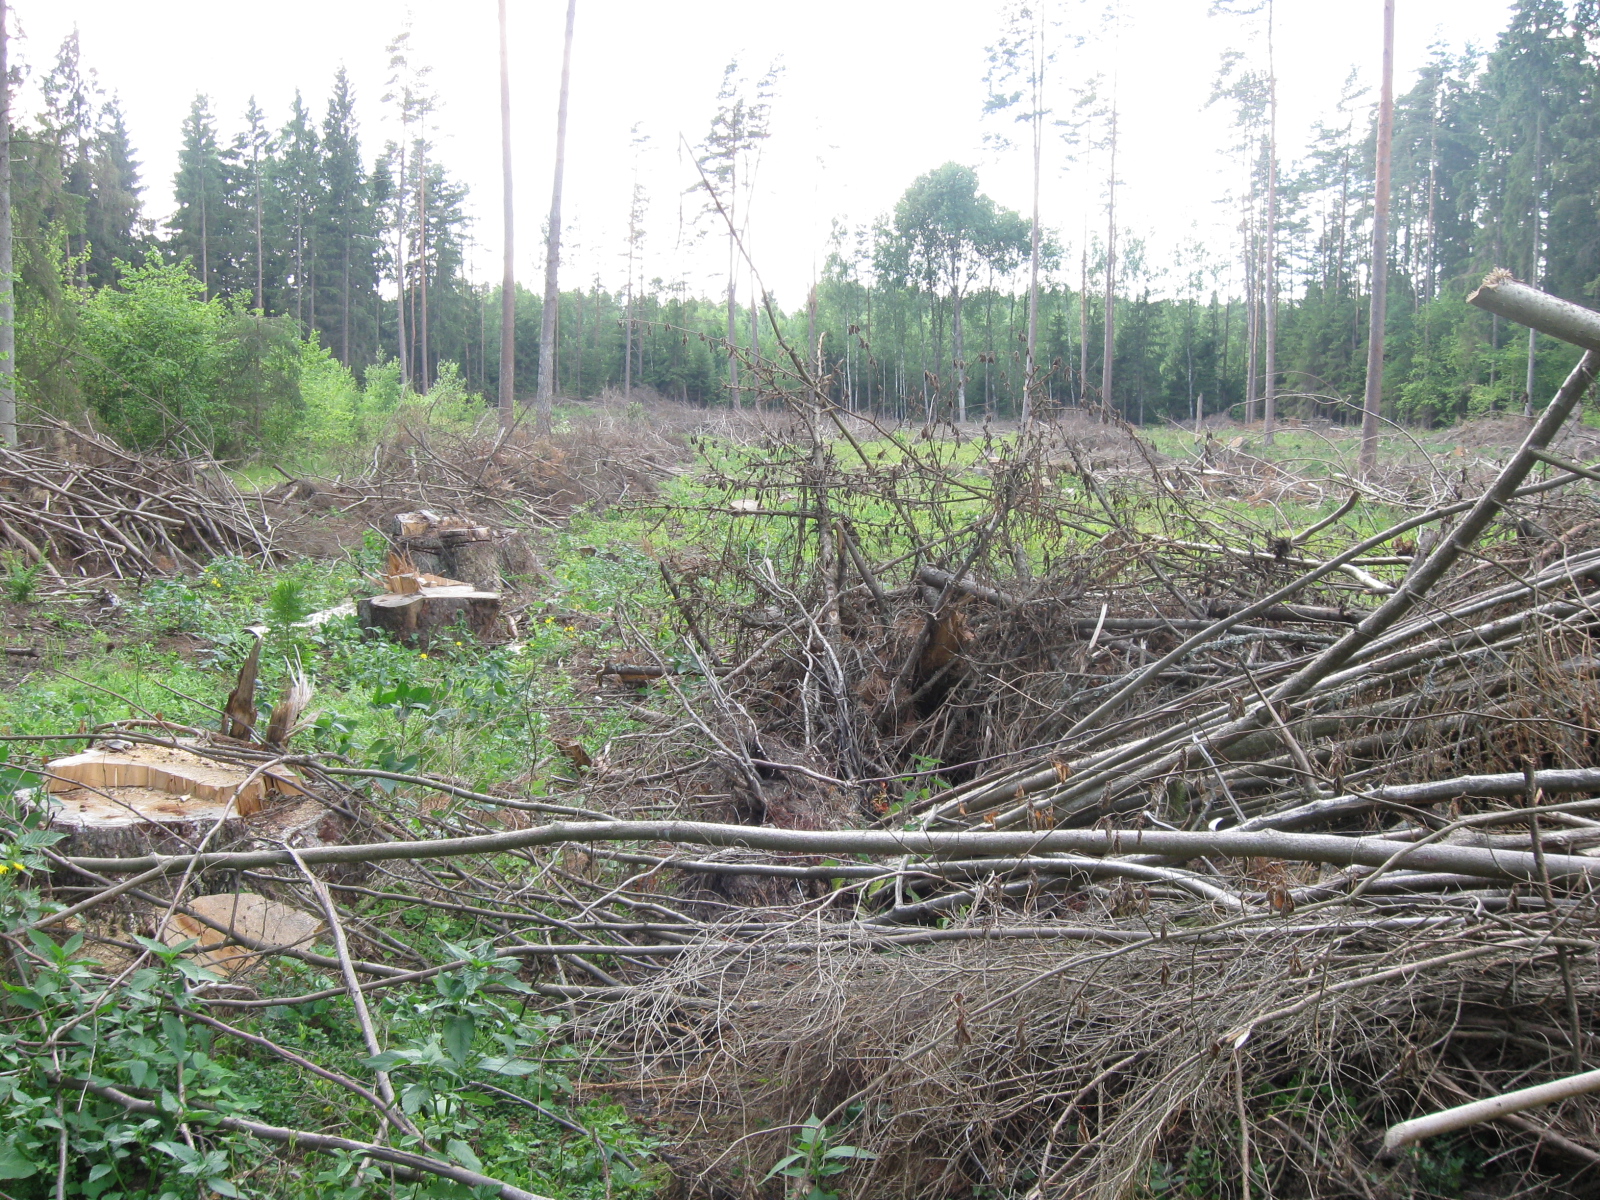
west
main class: Grassland
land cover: Spontaneously vegetated surfaces
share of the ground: > 75 %
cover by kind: herbaceous plants 75 %, unconsolidated bare surface 25 %
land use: Forestry
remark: Clear cut
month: July
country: LT
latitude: 54.2266
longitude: 24.3189
